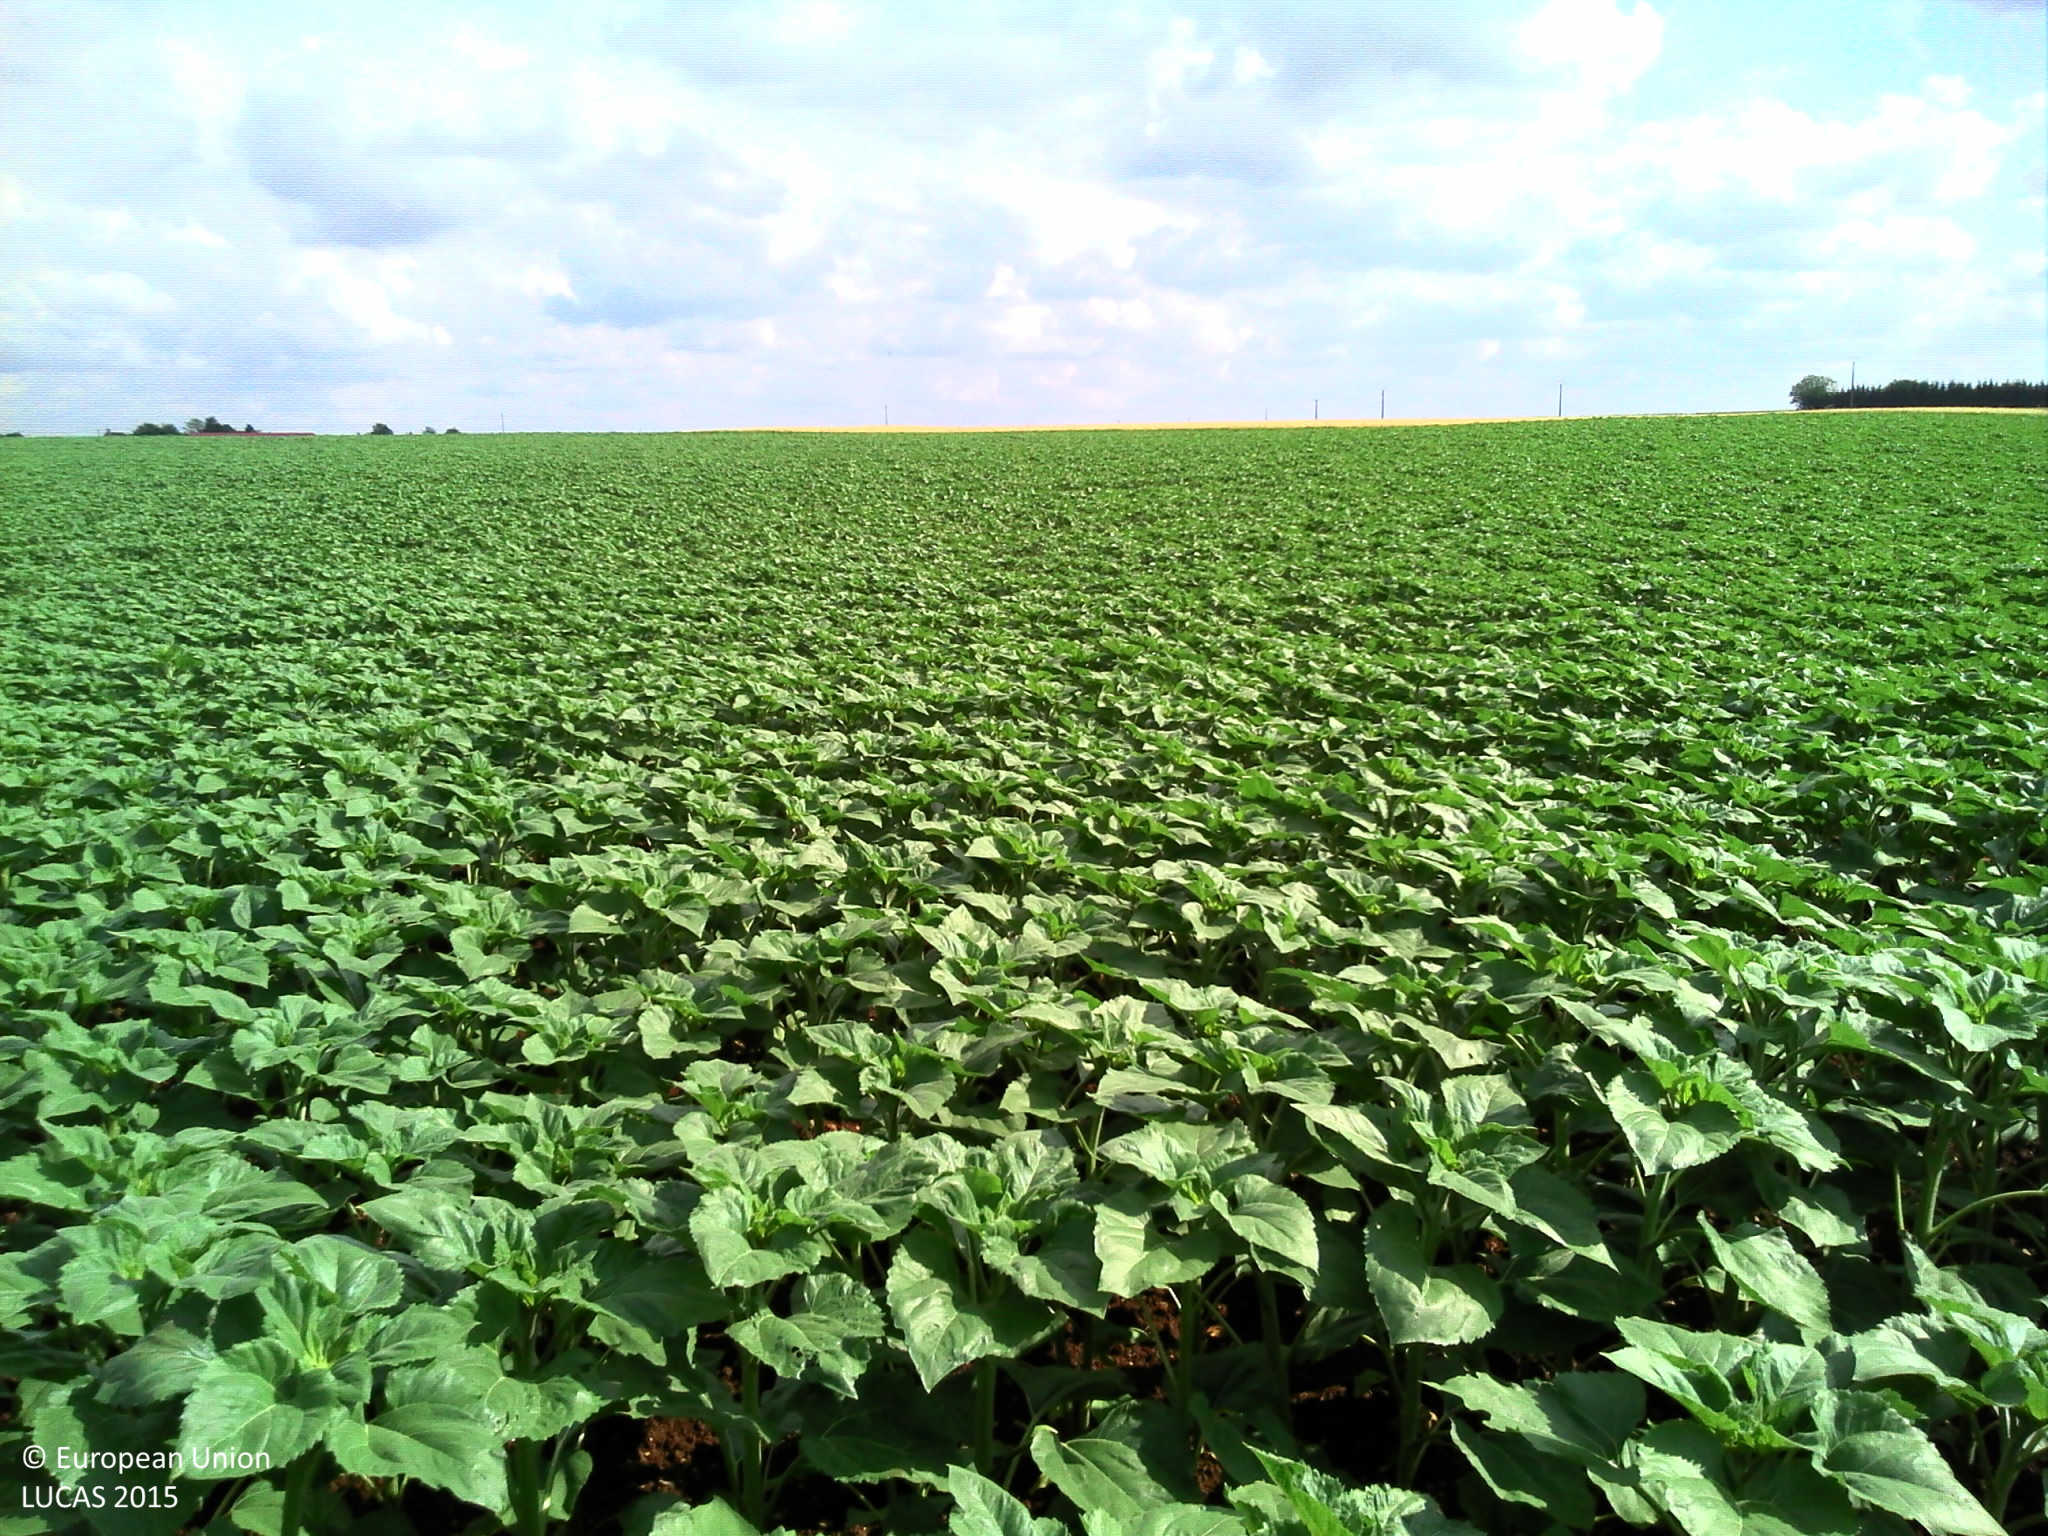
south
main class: Cropland
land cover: Sunflower
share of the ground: > 75 %
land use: Agriculture (excluding fallow land and kitchen gardens)
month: June
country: FR
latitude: 46.6991
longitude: 0.2100
